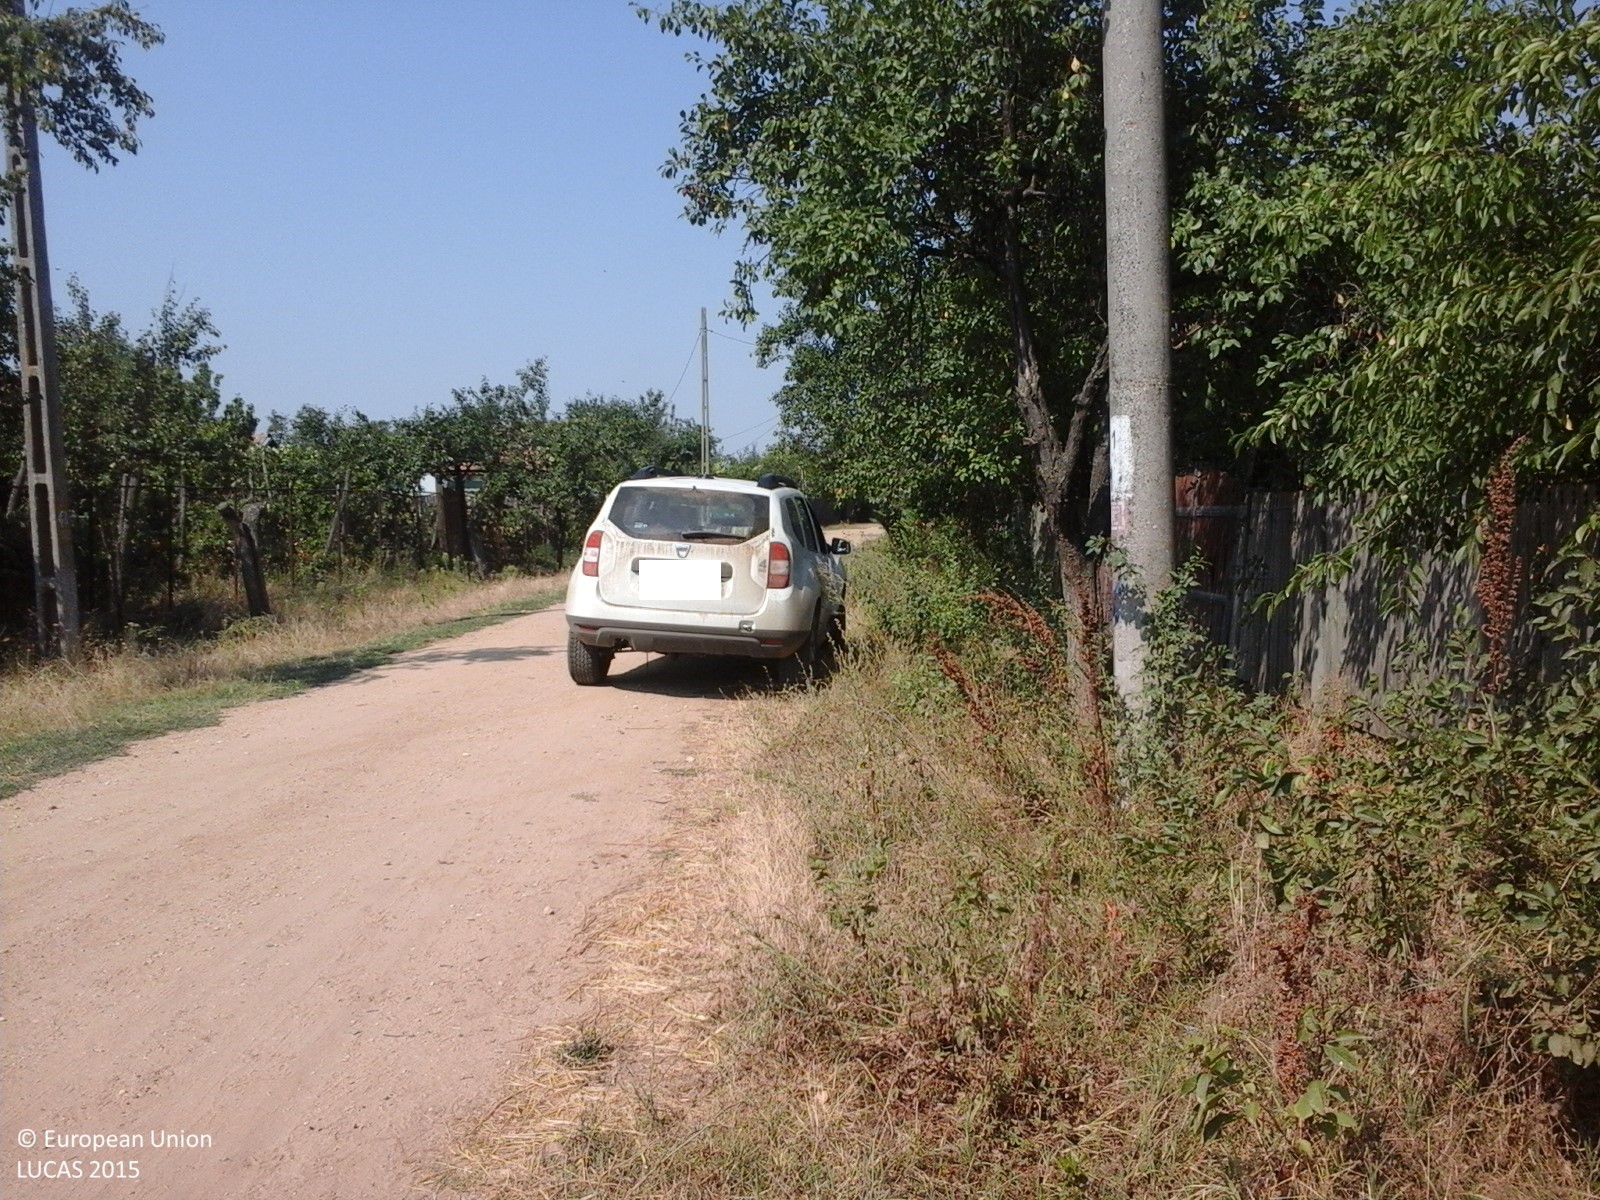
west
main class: Cropland
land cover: Other fruit trees and berries
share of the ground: 50 - 75 %
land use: Kitchen garden
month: August
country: RO
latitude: 44.3820
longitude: 23.0361
